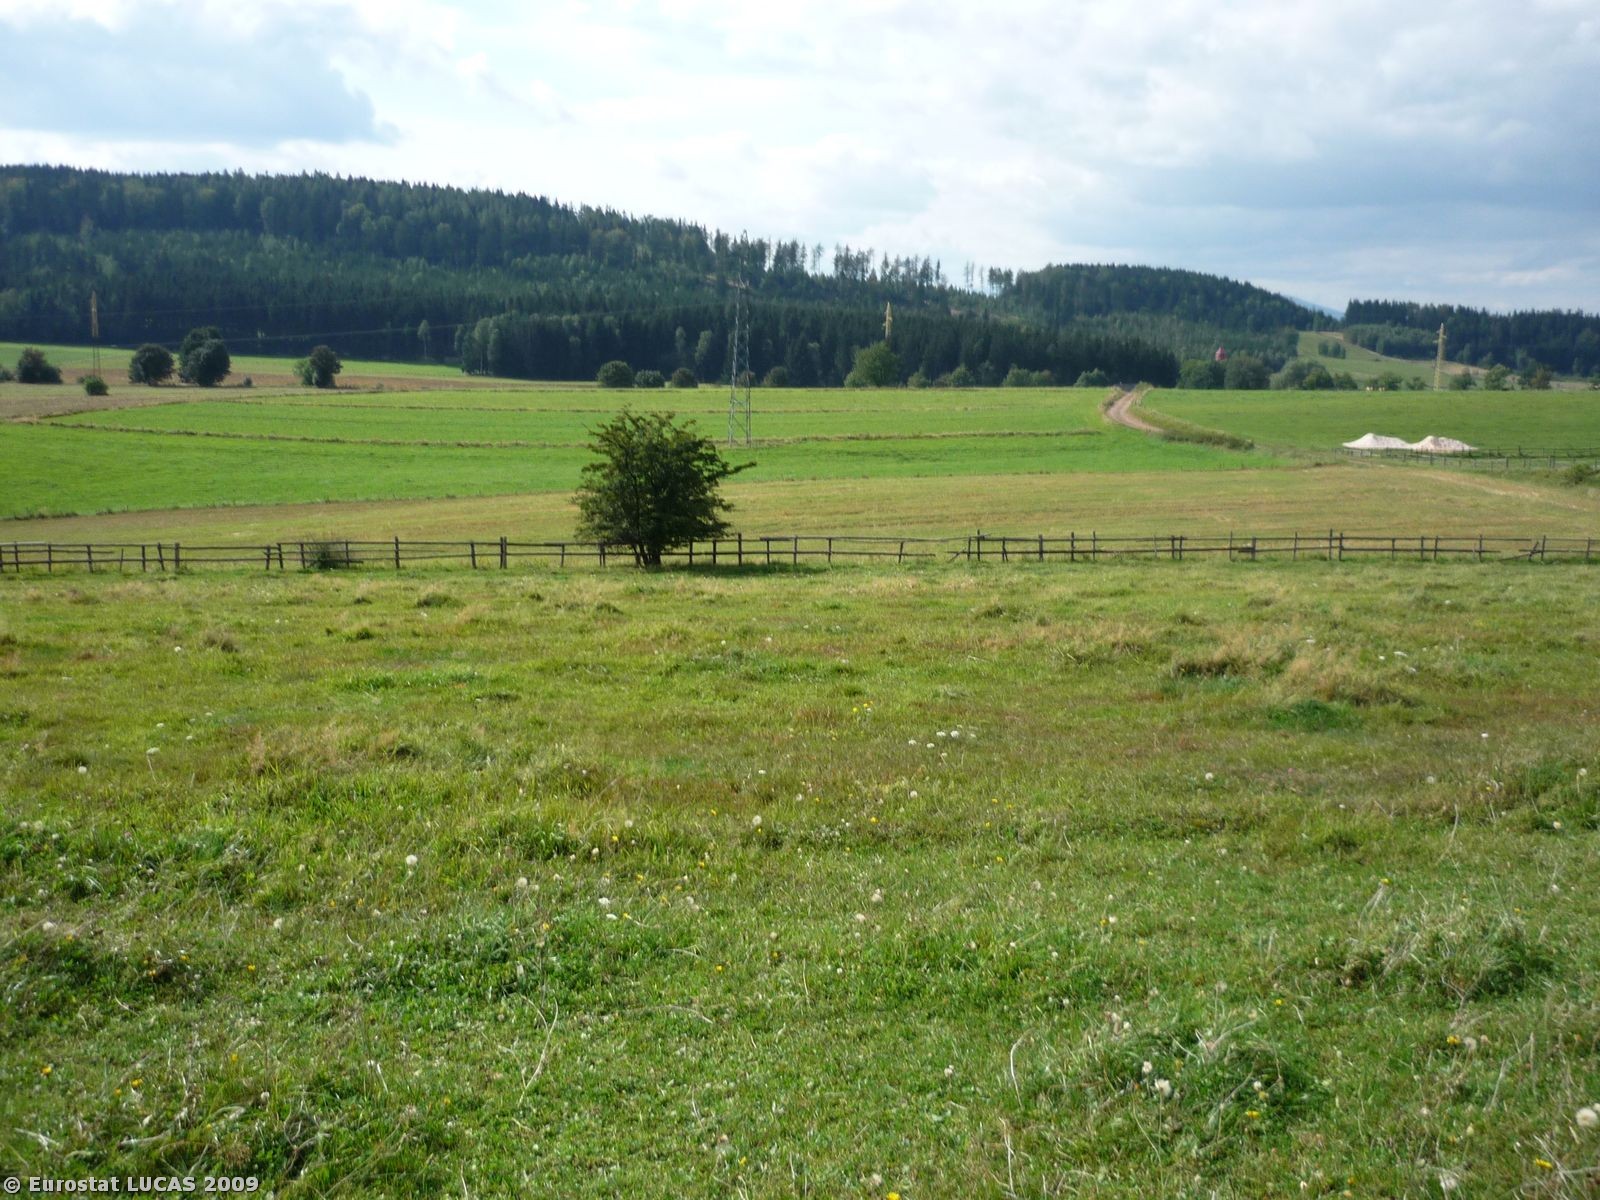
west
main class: Grassland
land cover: Grassland without tree/shrub cover
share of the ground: > 75 %
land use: Agriculture (excluding fallow land and kitchen gardens)
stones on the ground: 10 - 25 %
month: September
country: PL
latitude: 50.6848
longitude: 16.1633
